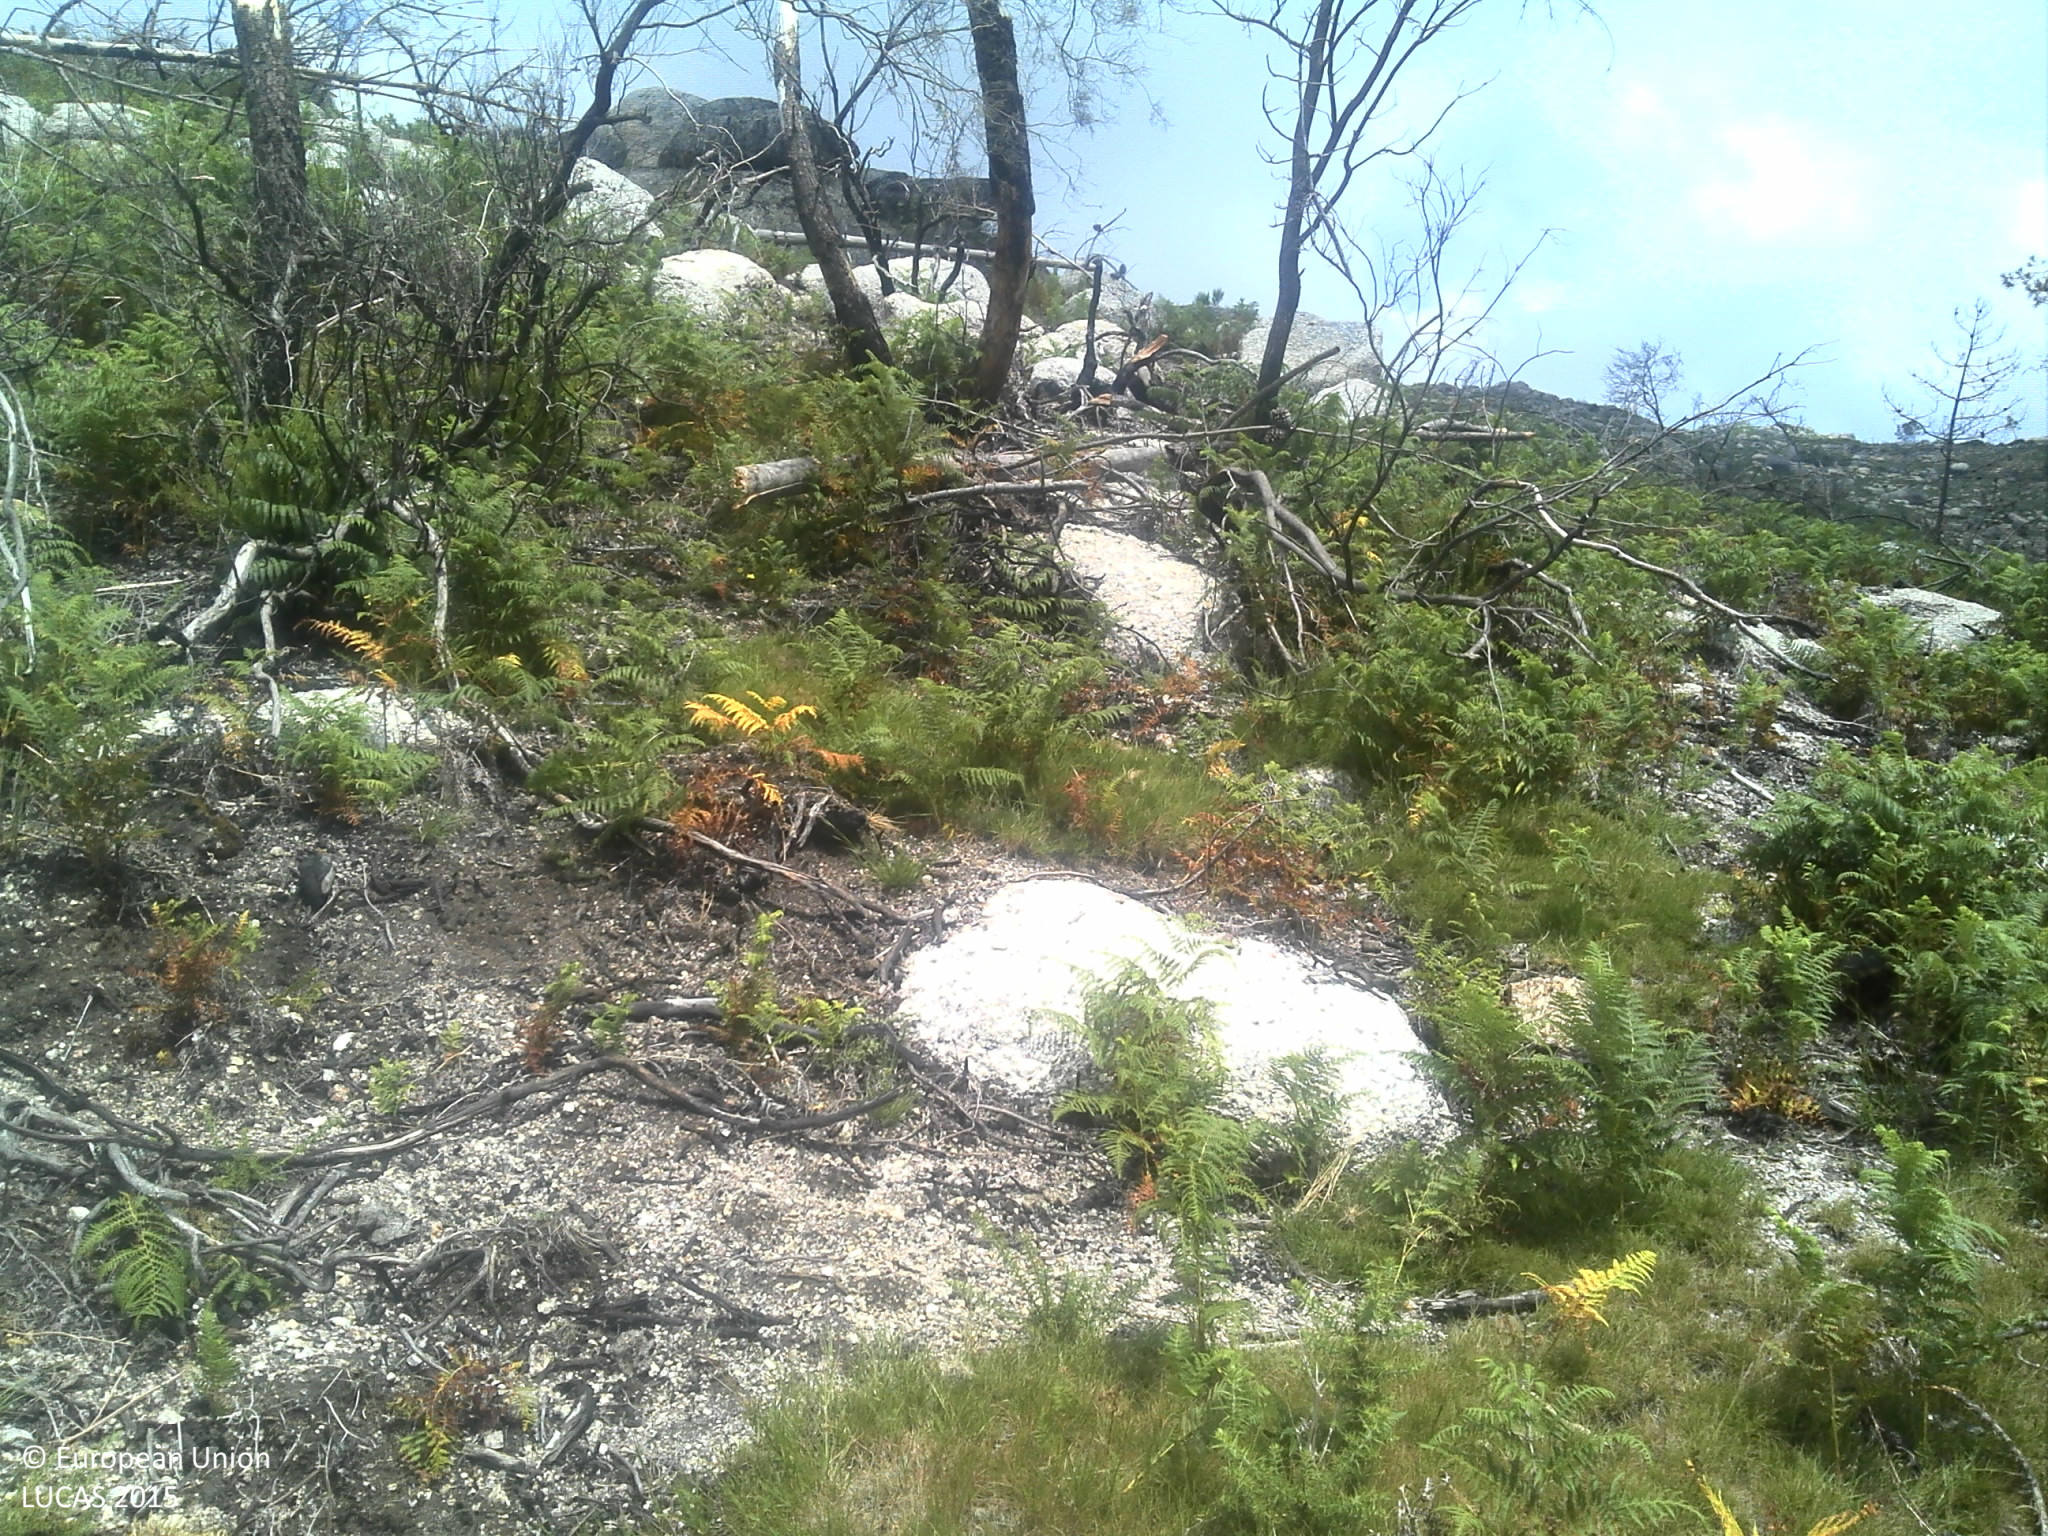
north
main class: Shrubland
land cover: Shrubland without tree cover
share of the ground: 50 - 75 %
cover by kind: shrubs 70 %, consolidated bare surface 20 %, unconsolidated bare surface 10 %
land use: Agriculture (excluding fallow land and kitchen gardens)
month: June
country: PT
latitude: 41.6846
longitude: -8.2309
